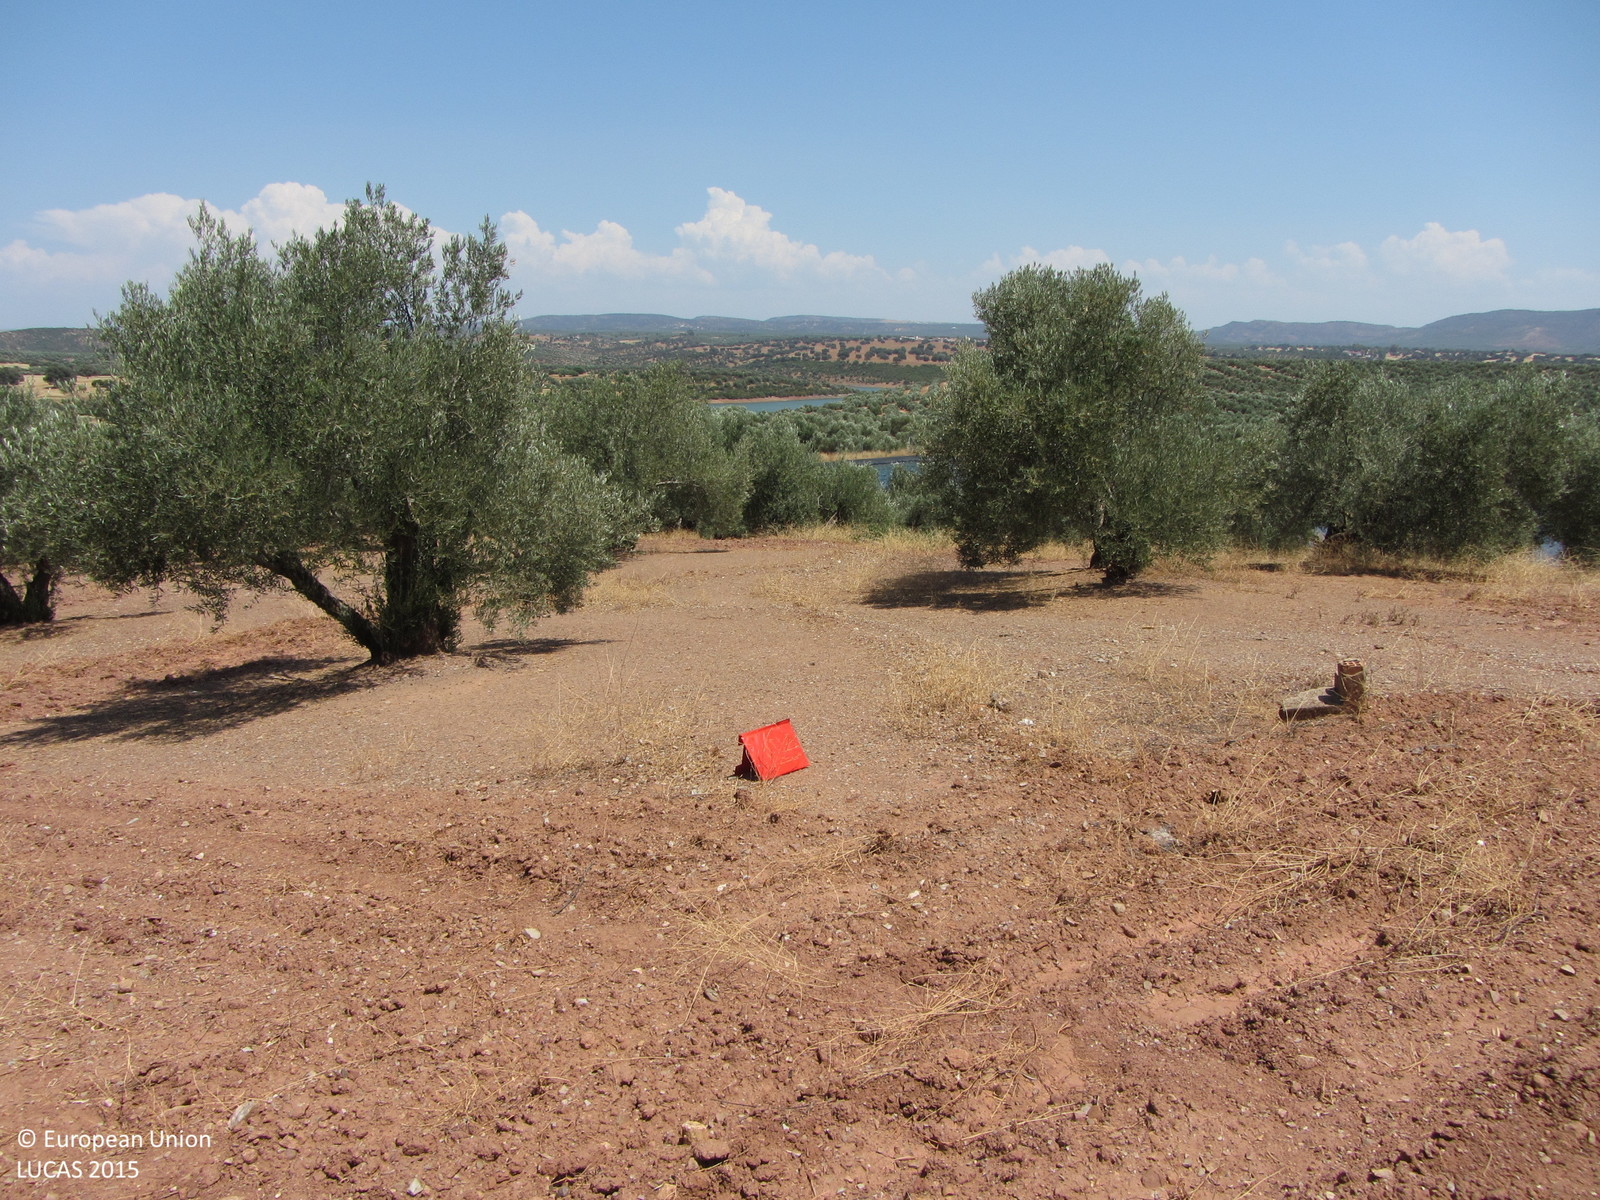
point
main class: Cropland
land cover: Olive groves
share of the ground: 25 - 50 %
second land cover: Other bare soil
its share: > 75 %
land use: Agriculture (excluding fallow land and kitchen gardens)
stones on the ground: 10 - 25 %
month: June
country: ES
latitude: 38.2367
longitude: -3.4512
